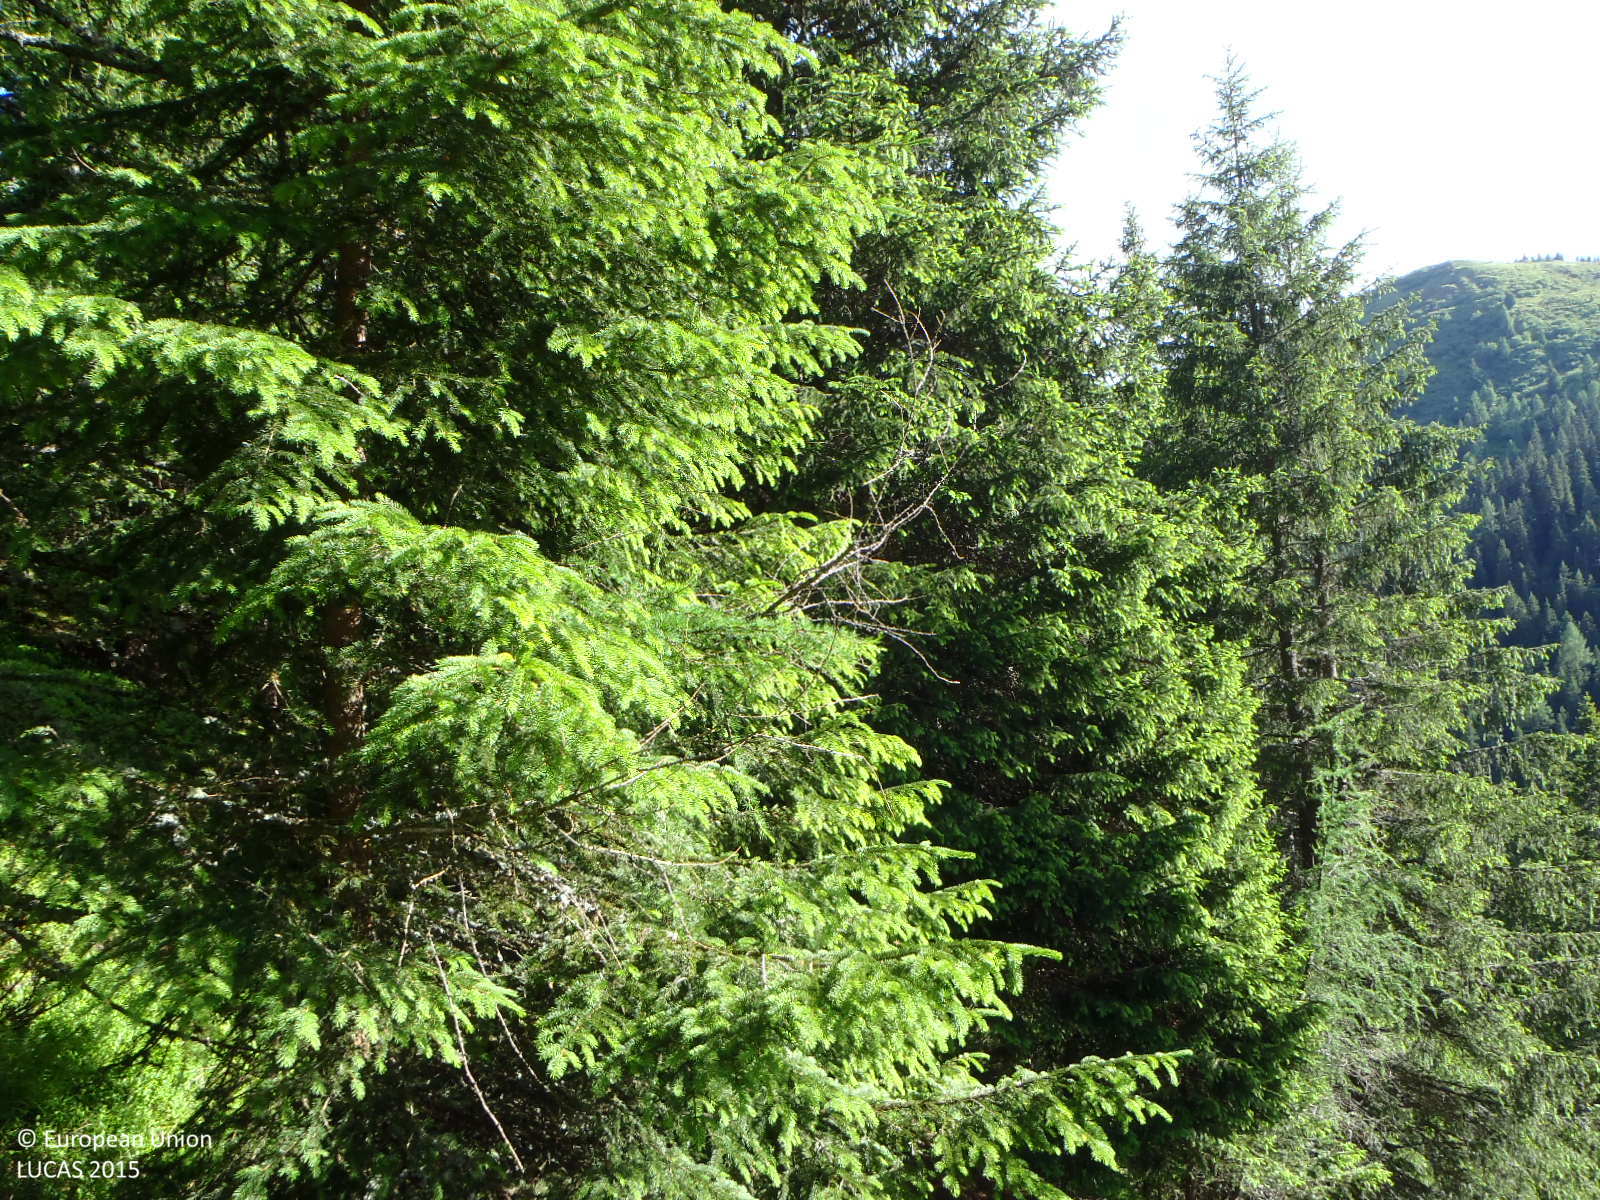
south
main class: Woodland
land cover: Other coniferous woodland
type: alpine coniferous forest
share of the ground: 50 - 75 %
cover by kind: coniferous forest trees 55 %, shrubs 20 %, herbaceous plants 20 %, lichens and mosses 5 %
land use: Forestry
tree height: > 5 m
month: June
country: AT
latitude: 47.3464
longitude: 12.6058
